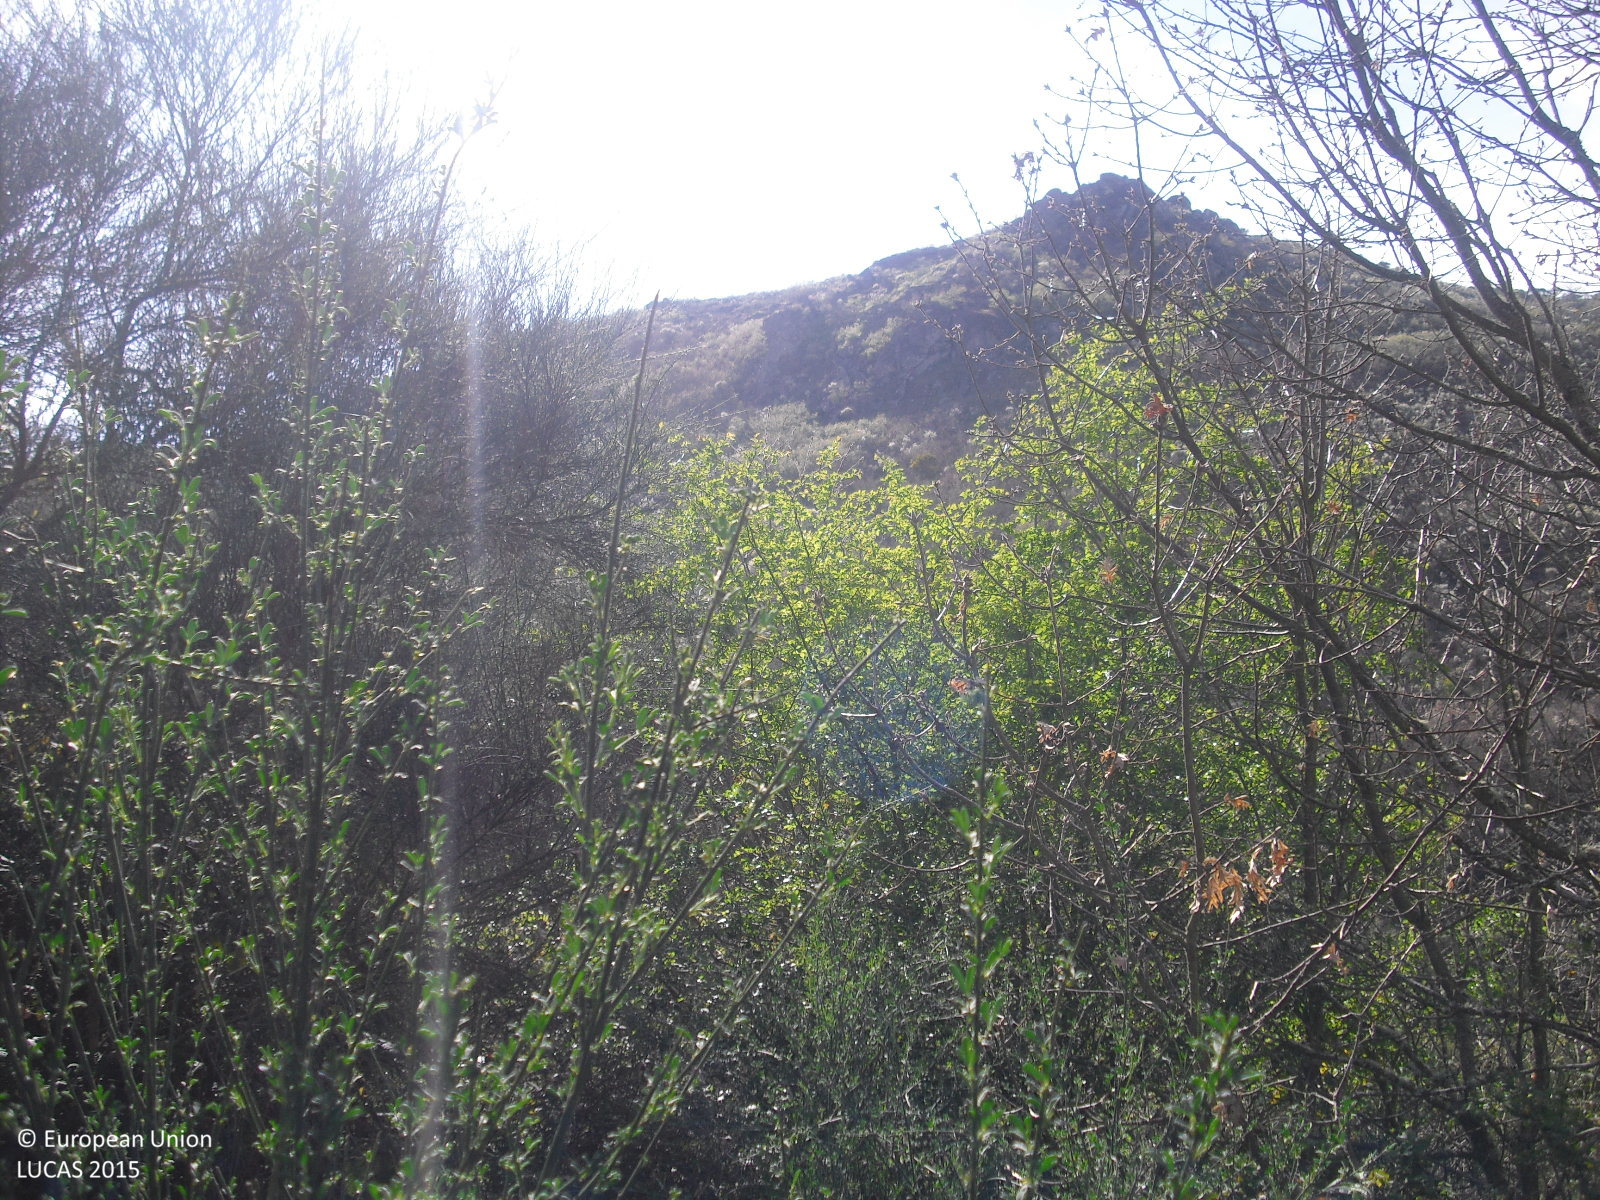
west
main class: Woodland
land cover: Broadleaved woodland
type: thermophilous deciduous forest
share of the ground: 50 - 75 %
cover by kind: broadleaved forest trees 60 %, shrubs 30 %, herbaceous plants 10 %
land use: Semi-natural and natural areas not in use
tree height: < 5 m
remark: Burnt area
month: April
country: ES
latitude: 41.9924
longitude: -7.6545
